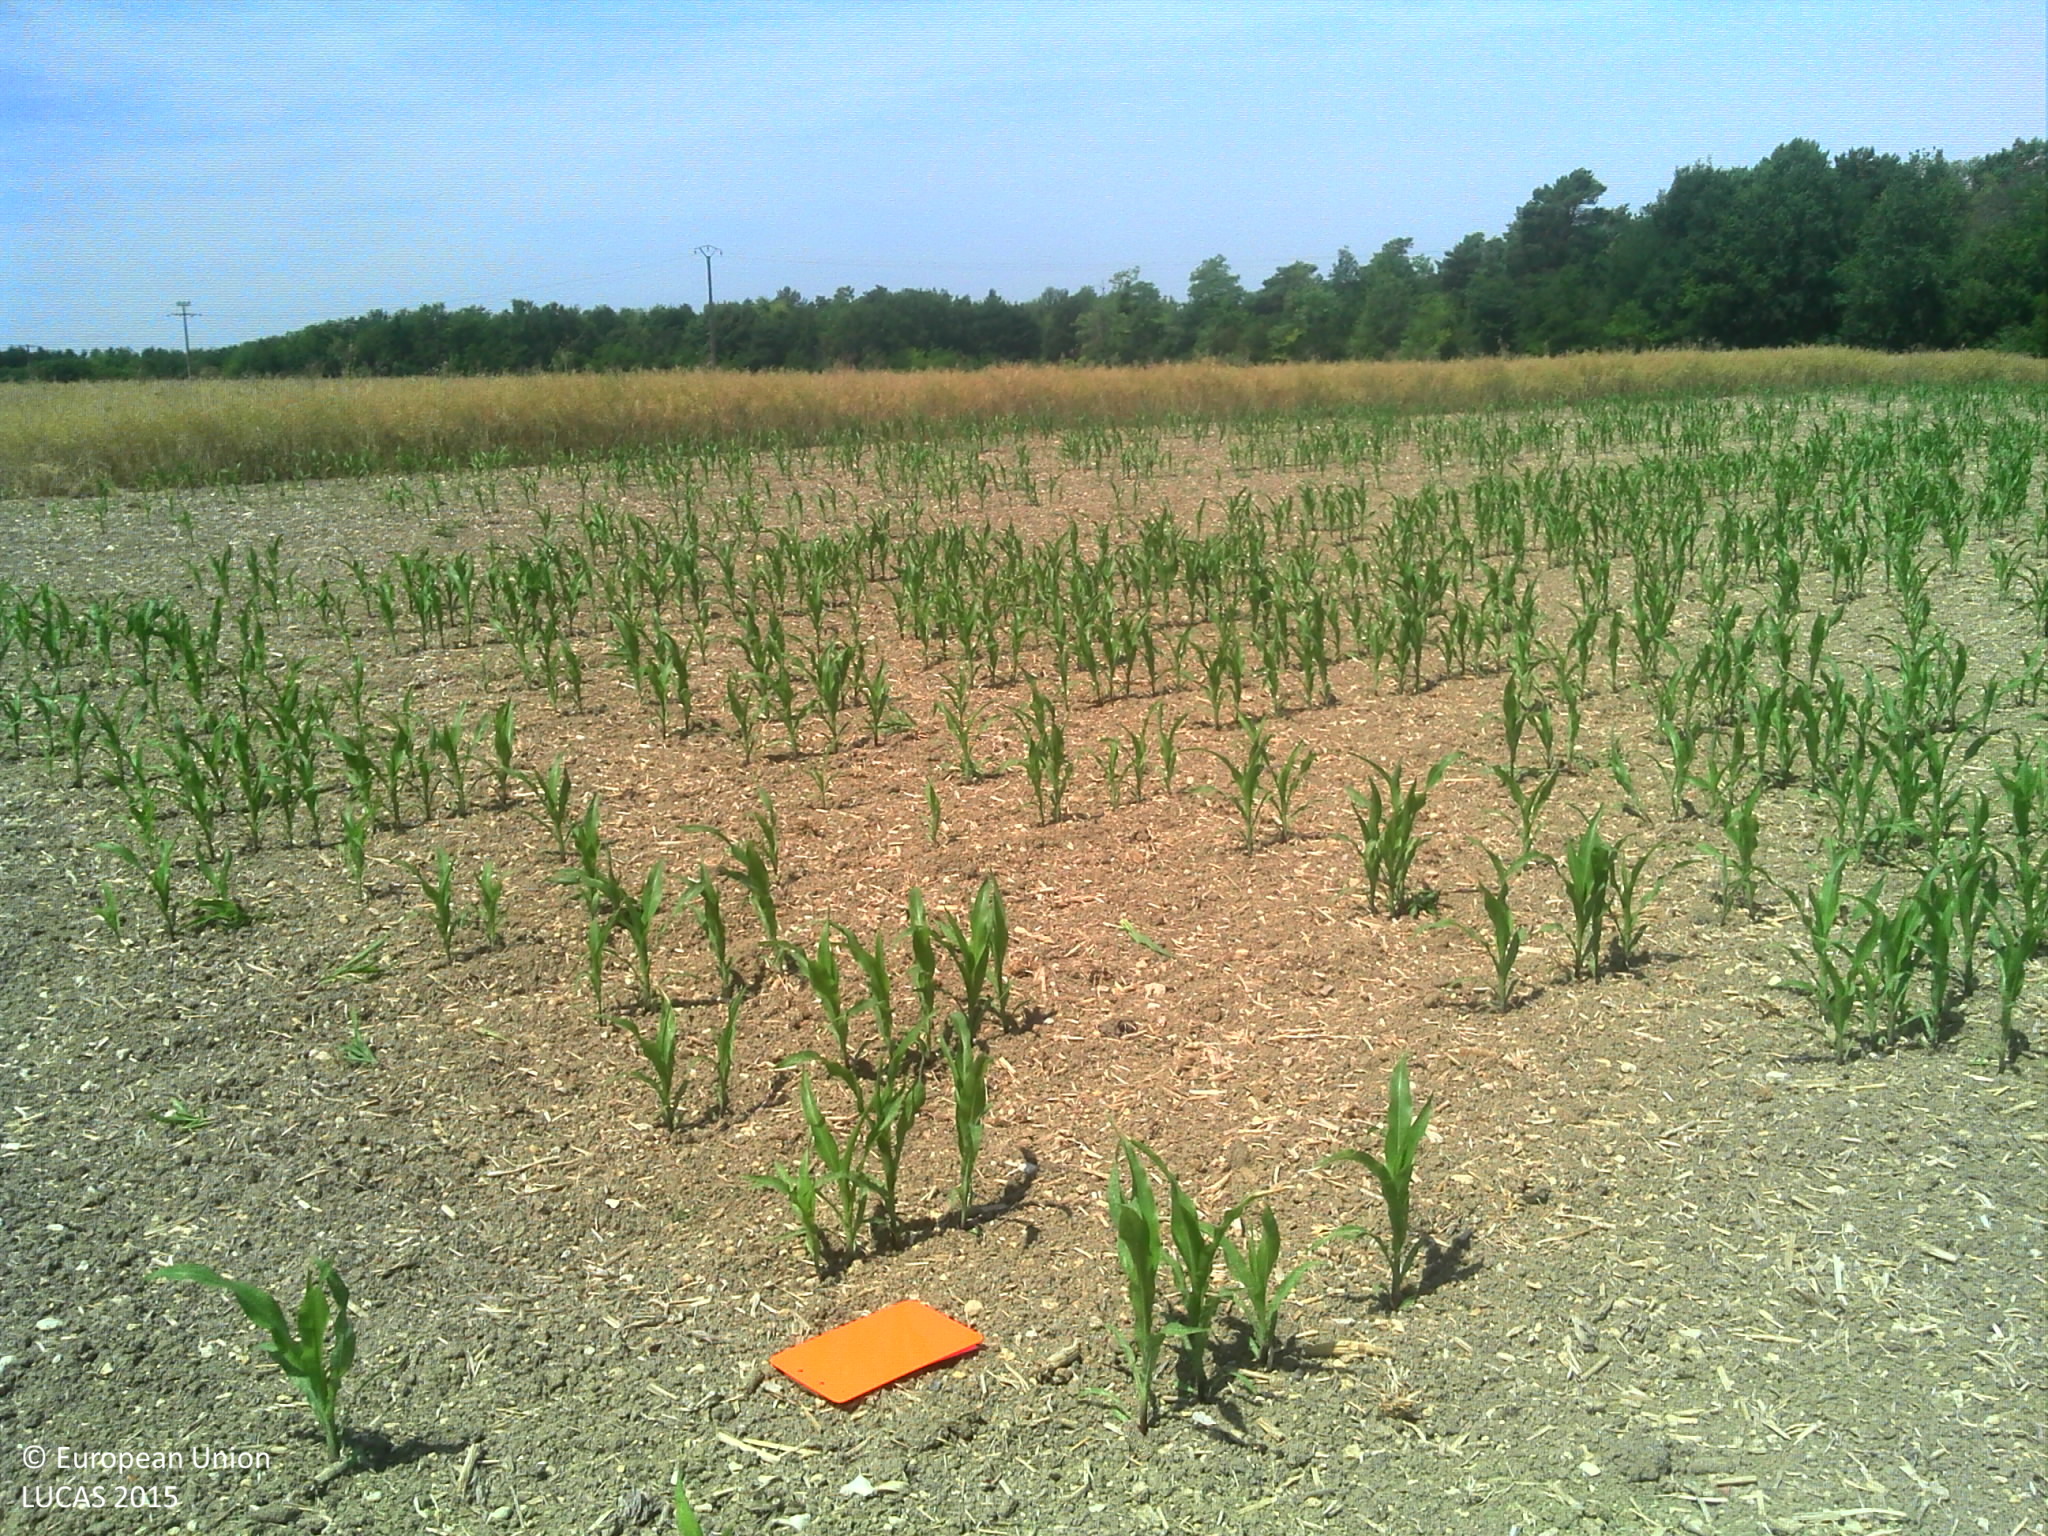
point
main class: Cropland
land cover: Maize
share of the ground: 10 - 25 %
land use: Agriculture (excluding fallow land and kitchen gardens)
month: June
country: FR
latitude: 47.4866
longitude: 1.3719
